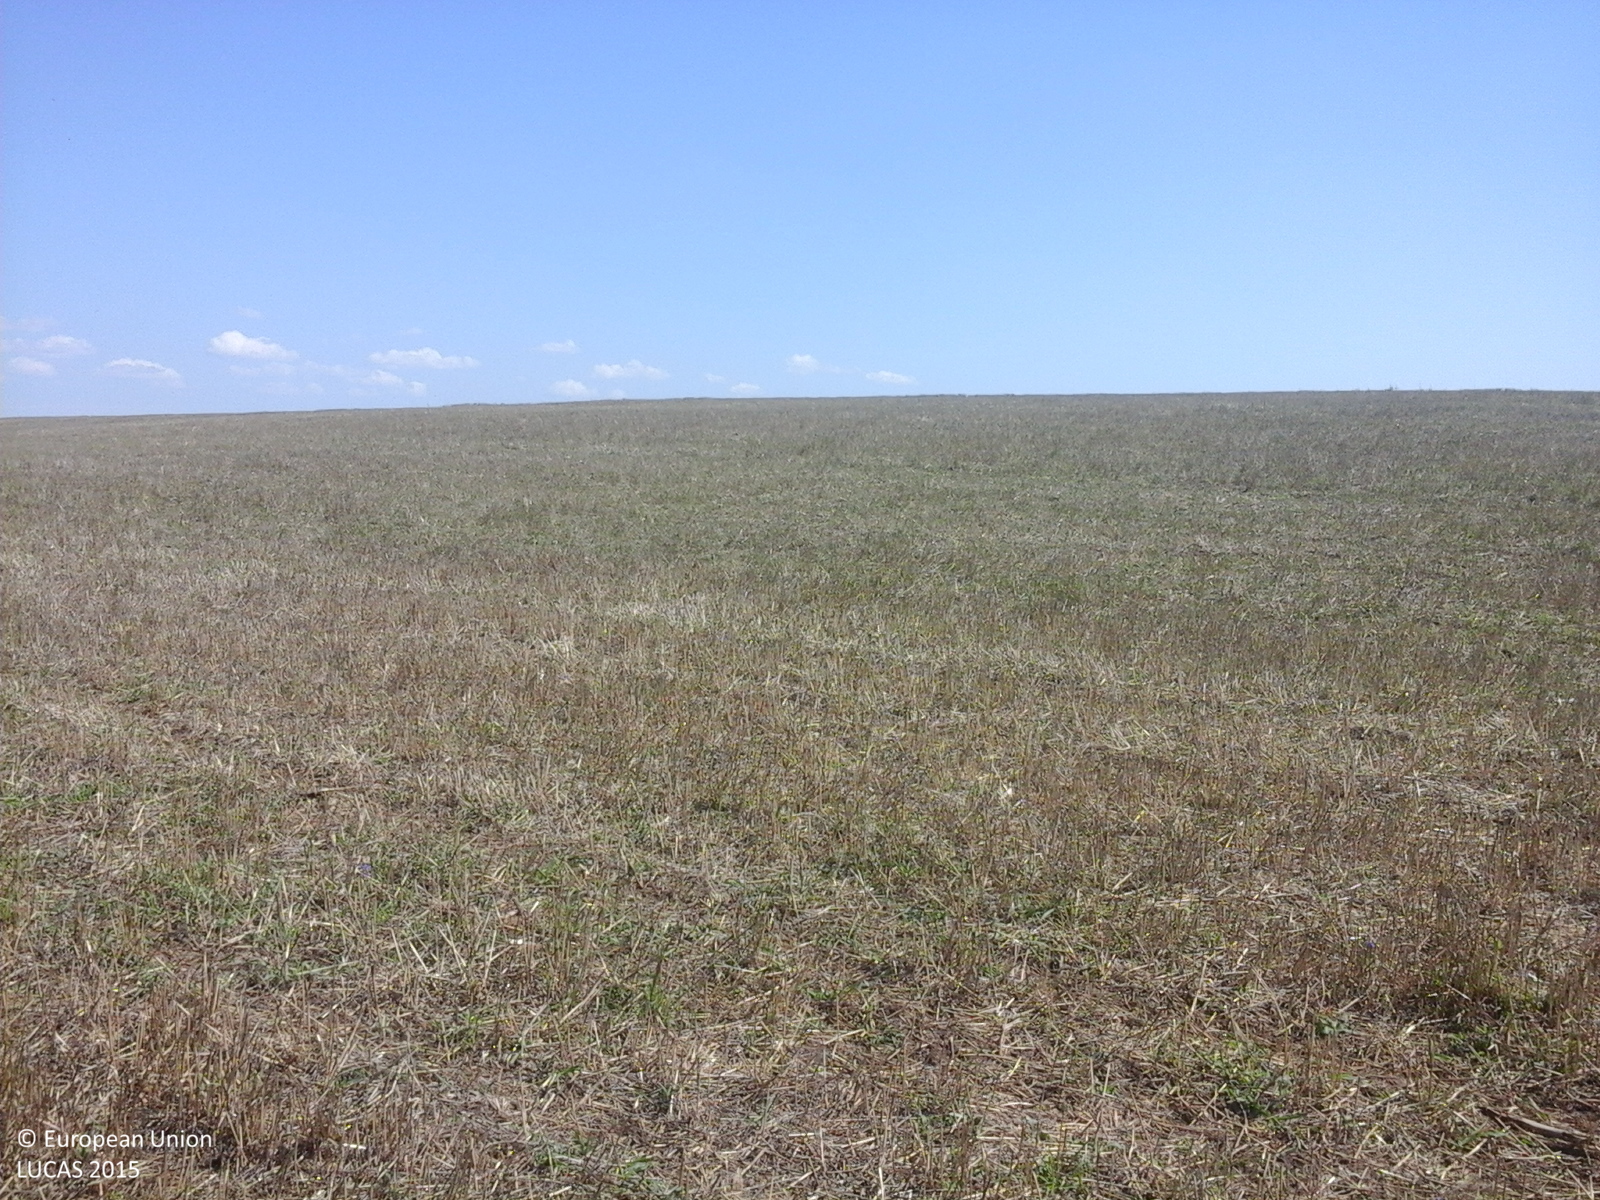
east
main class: Cropland
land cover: Common wheat
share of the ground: 50 - 75 %
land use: Agriculture (excluding fallow land and kitchen gardens)
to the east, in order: Common wheat
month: August
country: RO
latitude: 45.9671
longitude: 21.1418
